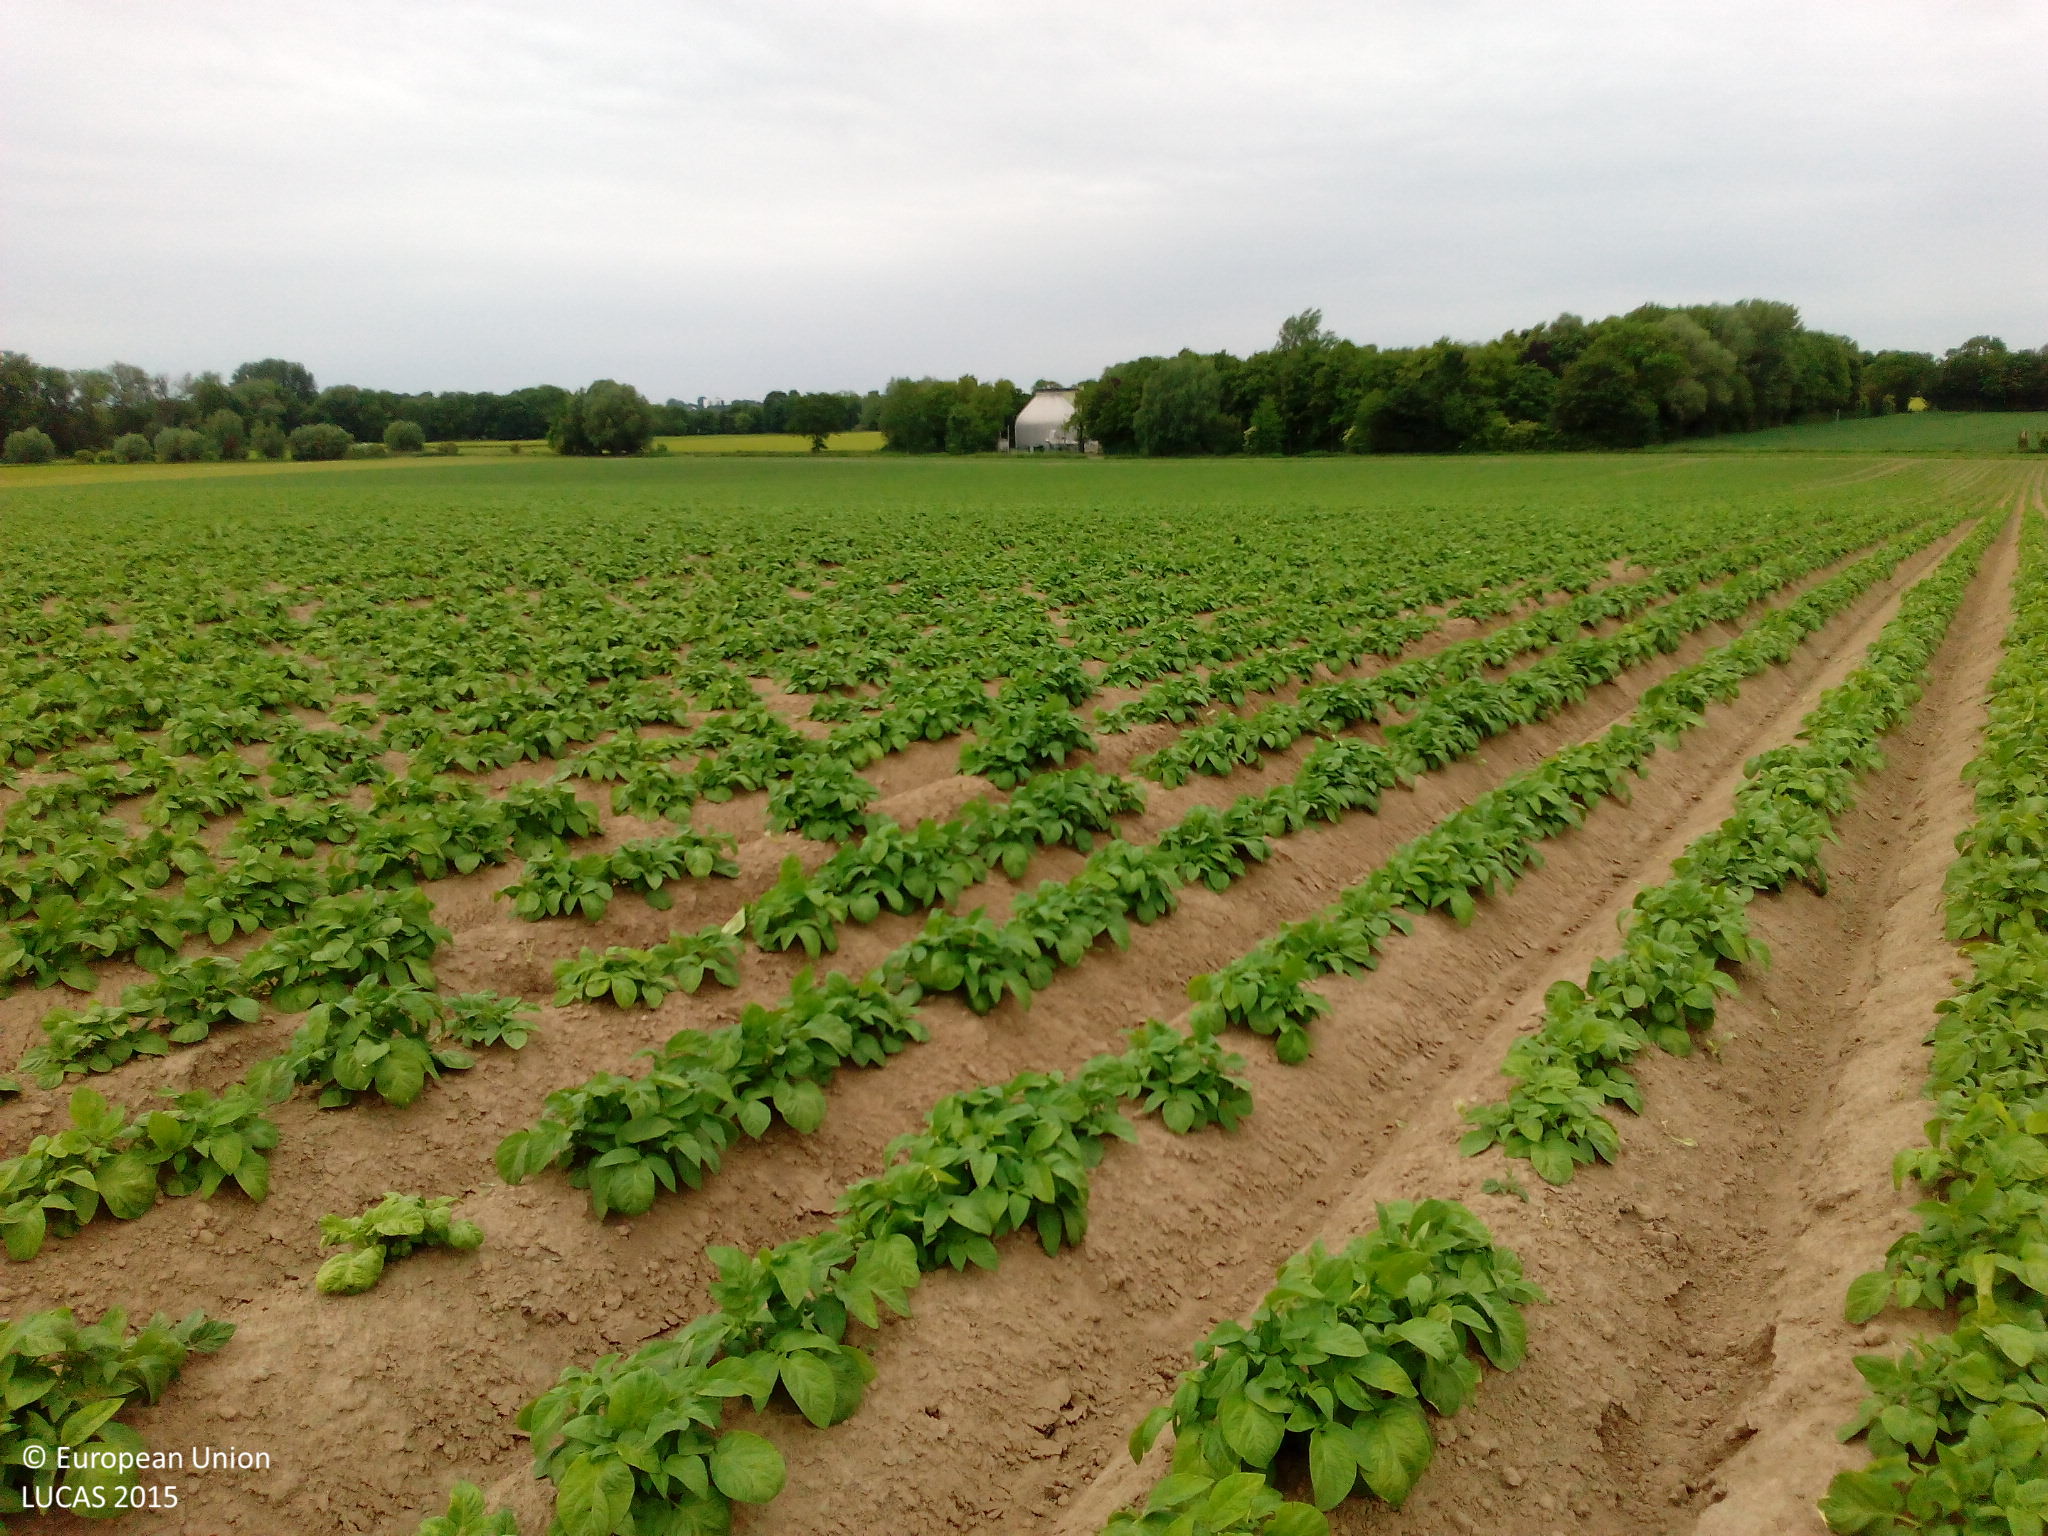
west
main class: Cropland
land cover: Potatoes
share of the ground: 25 - 50 %
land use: Agriculture (excluding fallow land and kitchen gardens)
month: June
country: DE
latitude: 51.5689
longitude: 7.9661
